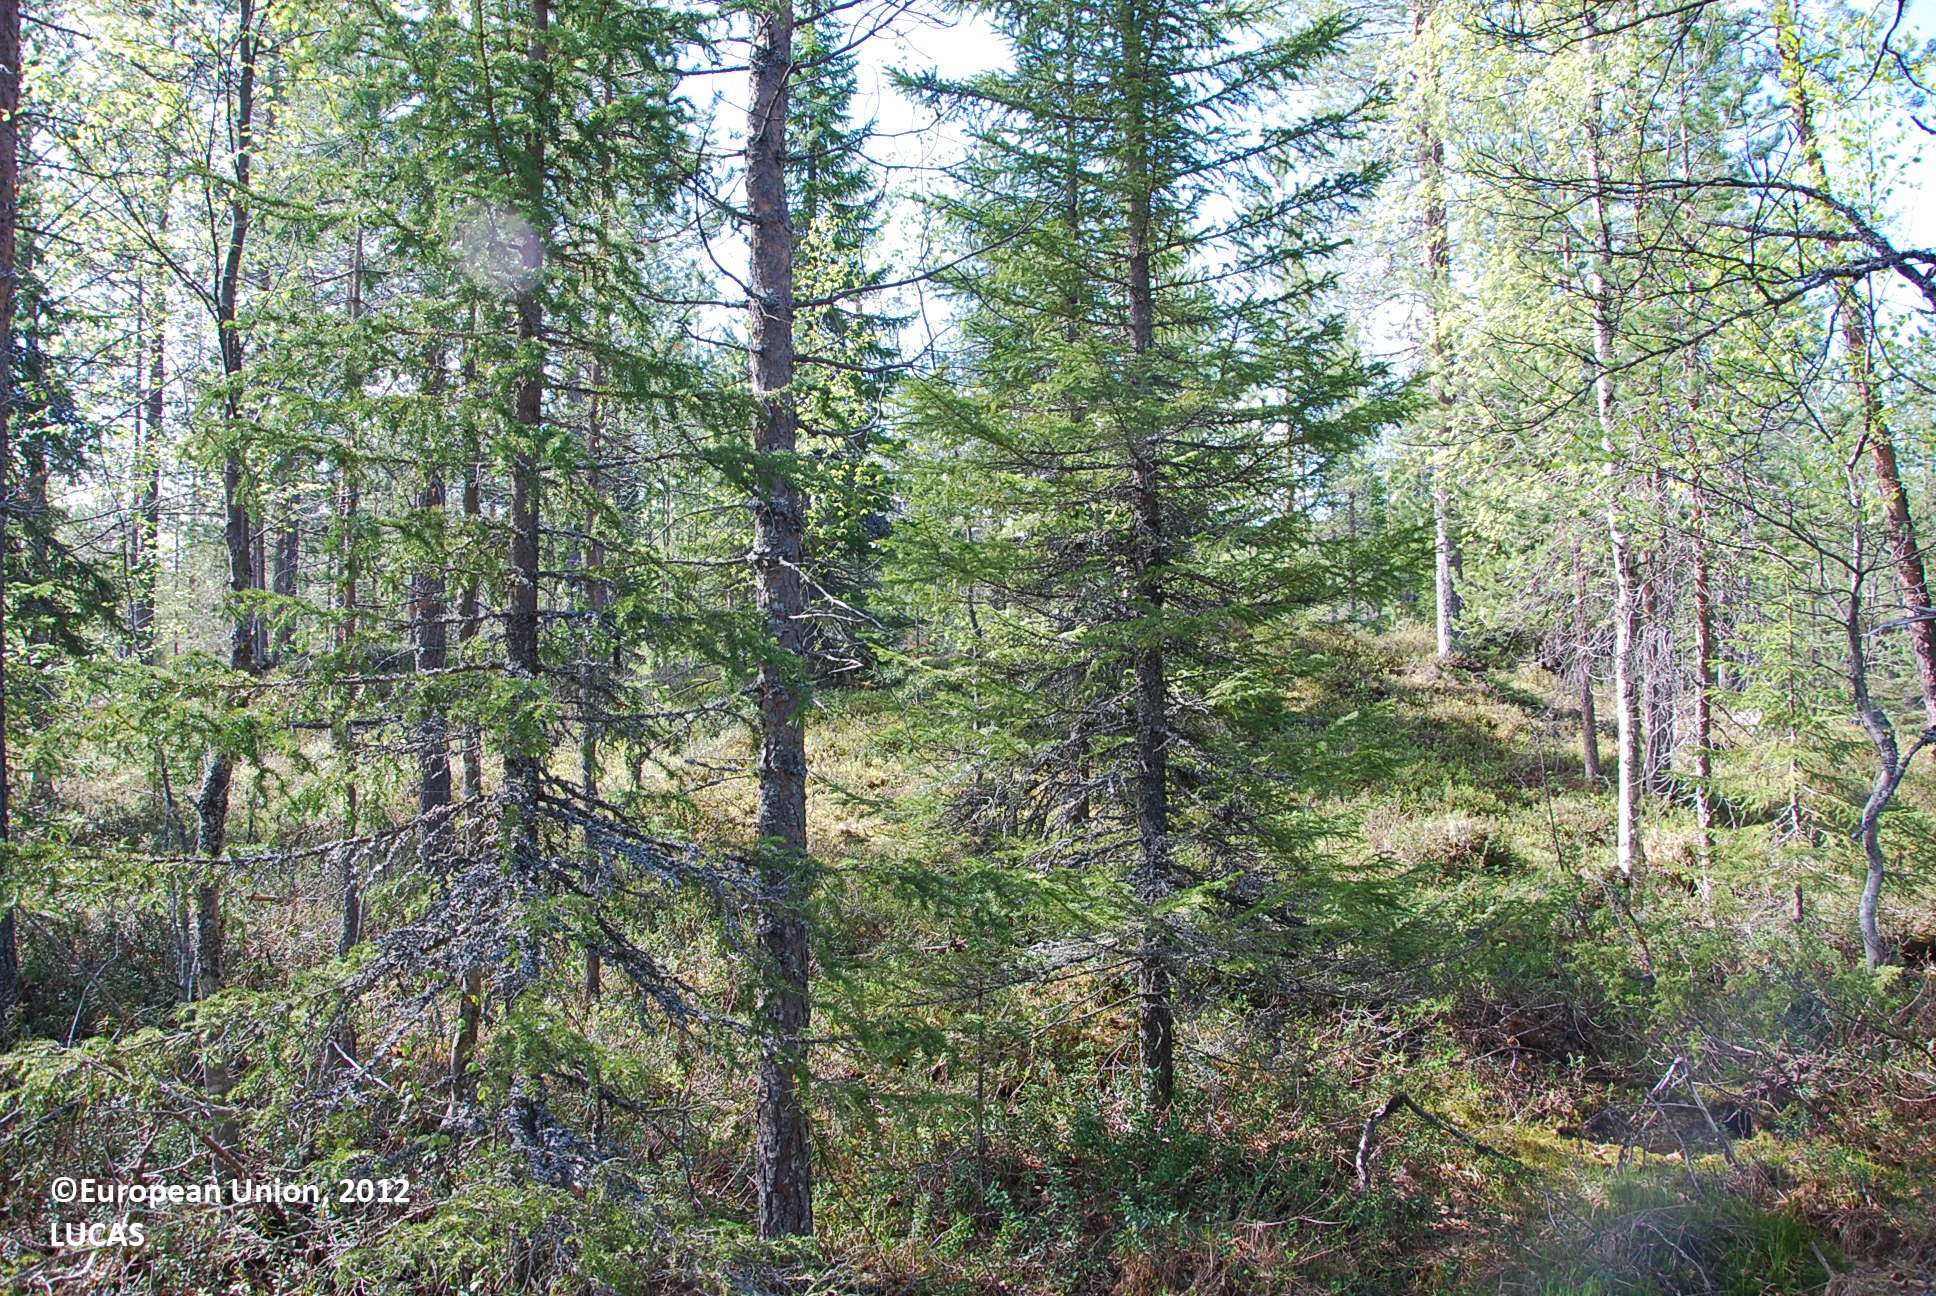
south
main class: Woodland
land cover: Other mixed woodland
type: boreal forest
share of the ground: > 75 %
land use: Forestry
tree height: > 5 m
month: June
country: FI
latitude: 66.3406
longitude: 27.8357
